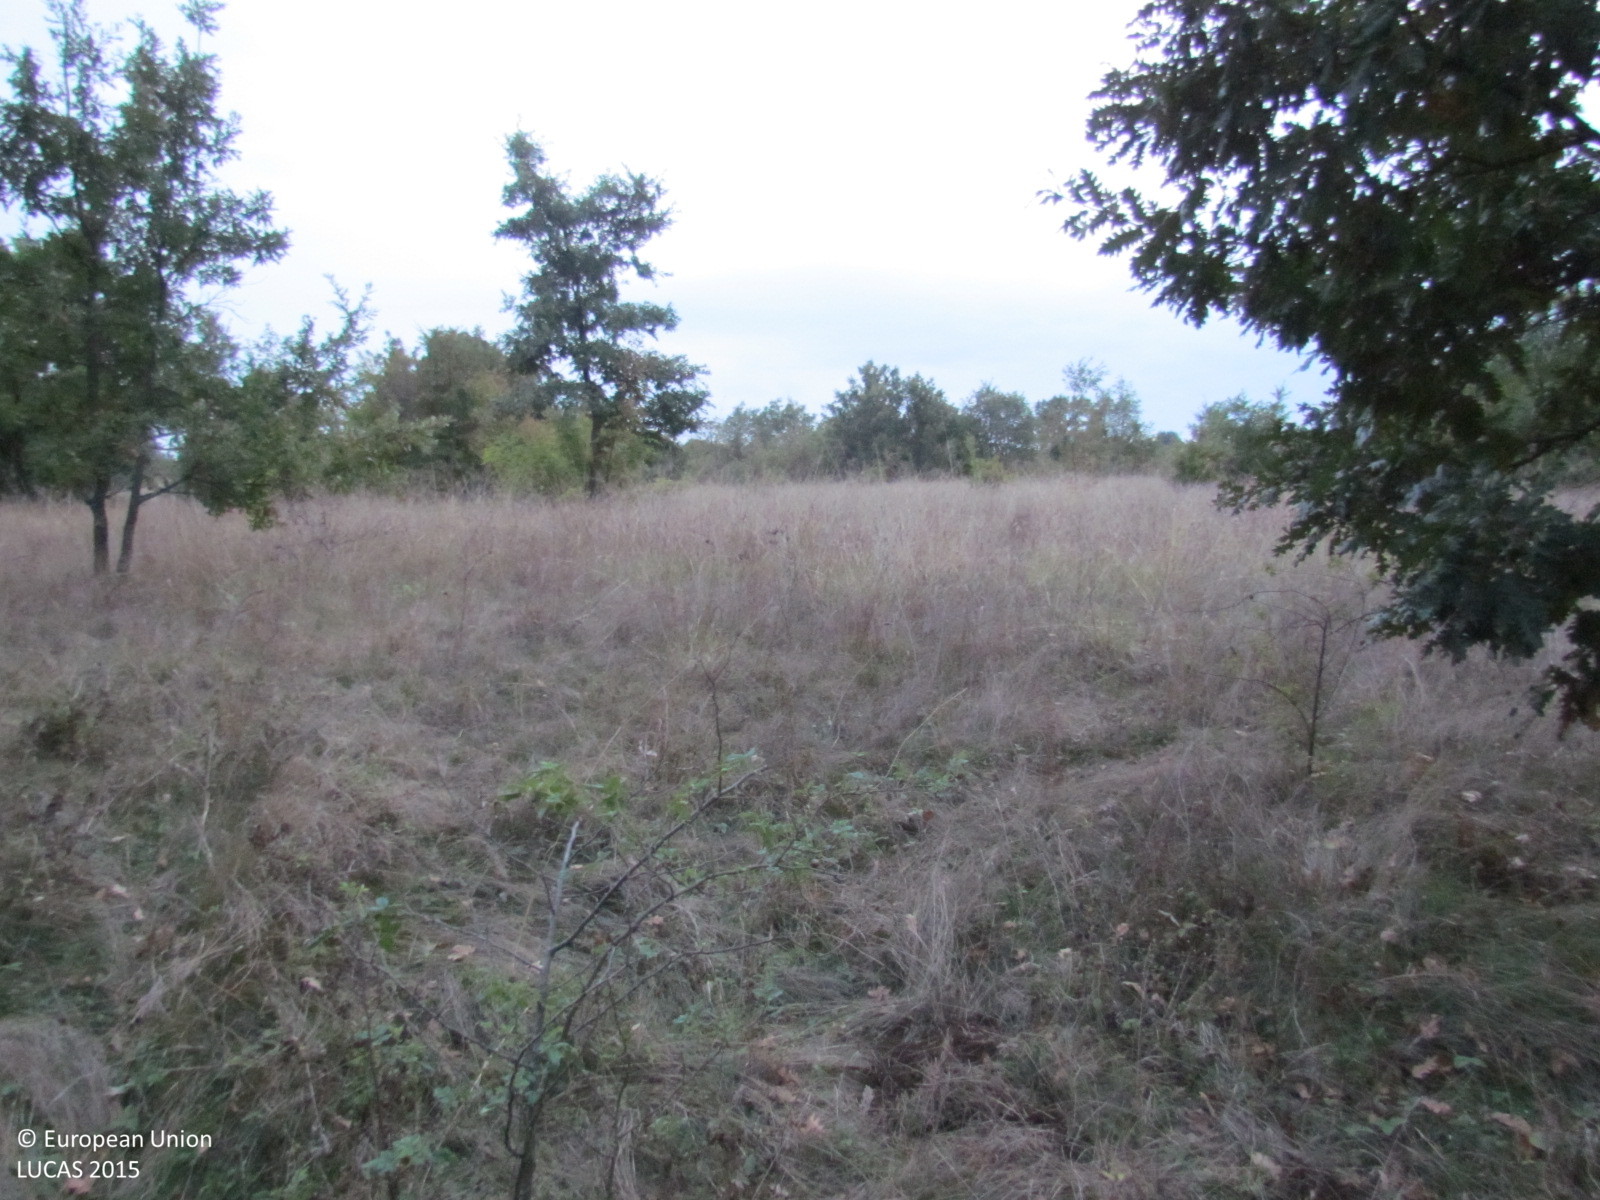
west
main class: Woodland
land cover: Broadleaved woodland
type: acidophilous oak and oak-birch forest
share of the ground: > 75 %
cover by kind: broadleaved forest trees 80 %, shrubs 10 %, herbaceous plants 10 %
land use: Forestry
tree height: > 5 m
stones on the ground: < 10 %
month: October
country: BG
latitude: 42.6989
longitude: 26.7643
